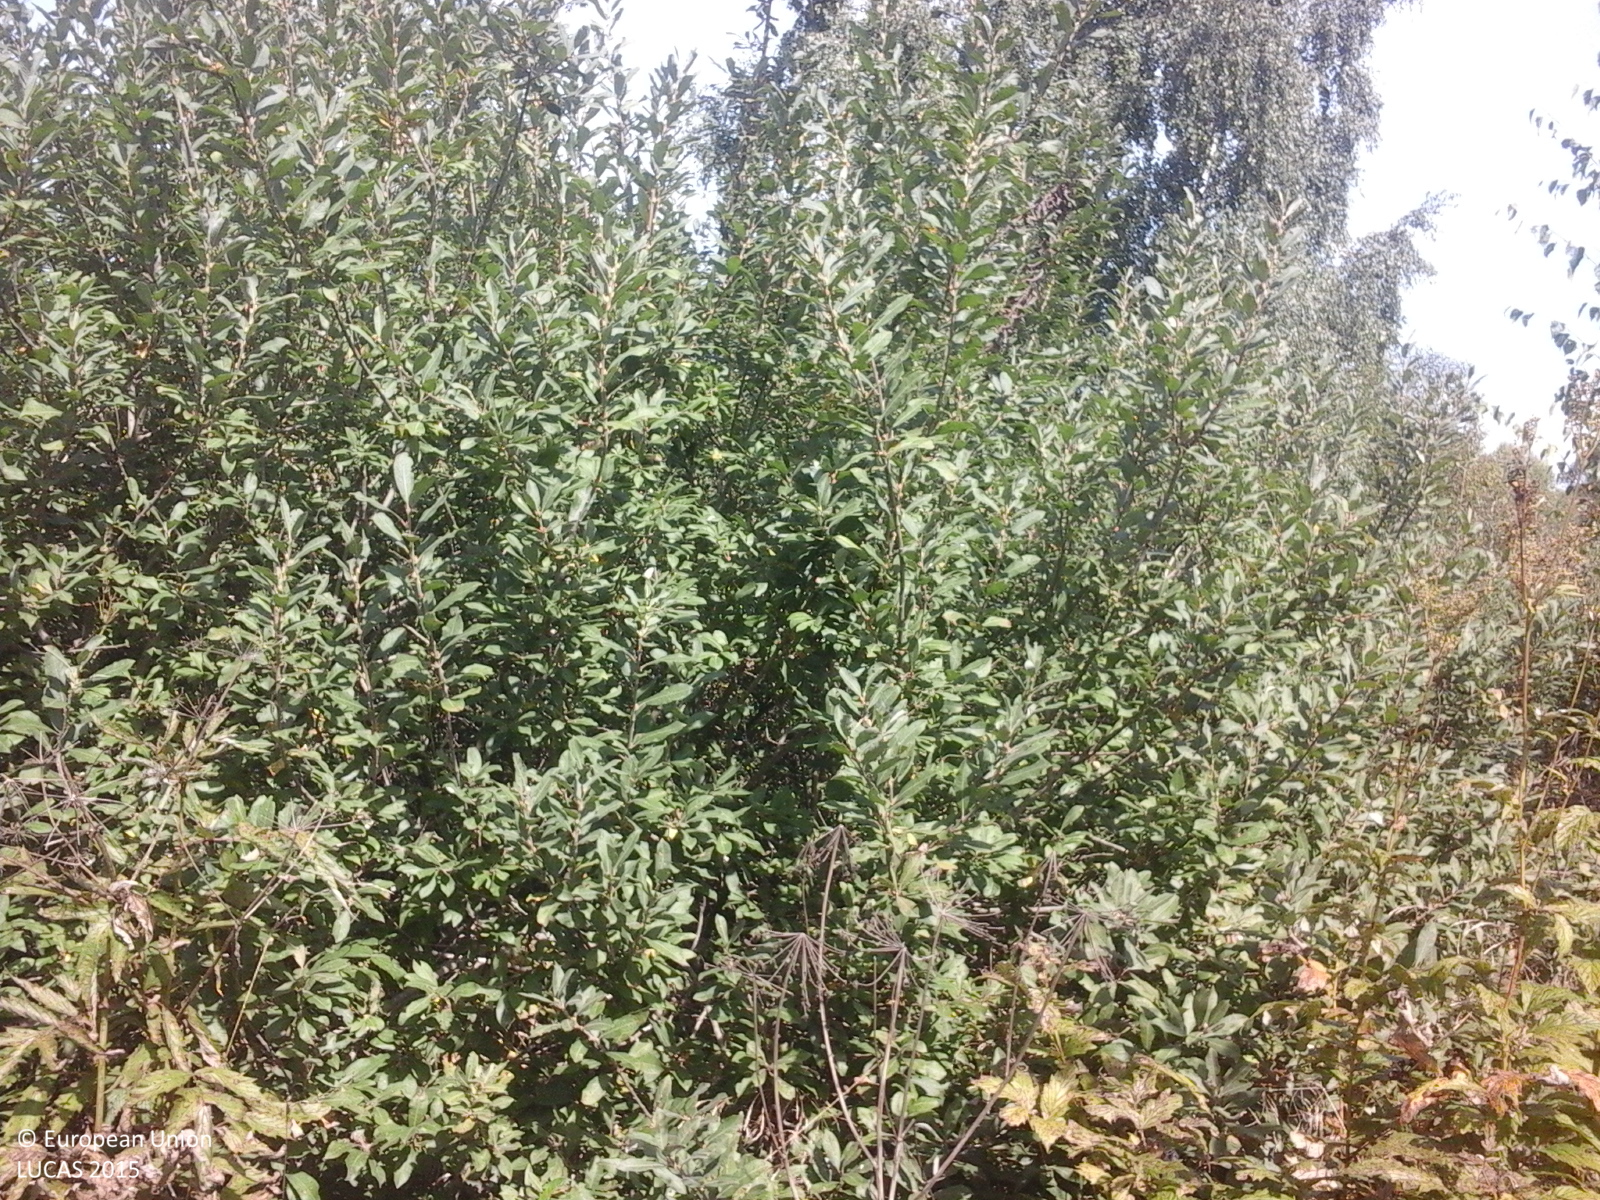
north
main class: Shrubland
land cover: Shrubland without tree cover
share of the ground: > 75 %
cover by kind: shrubs 100 %
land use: Fallow land
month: September
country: RO
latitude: 46.7644
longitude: 23.0906
